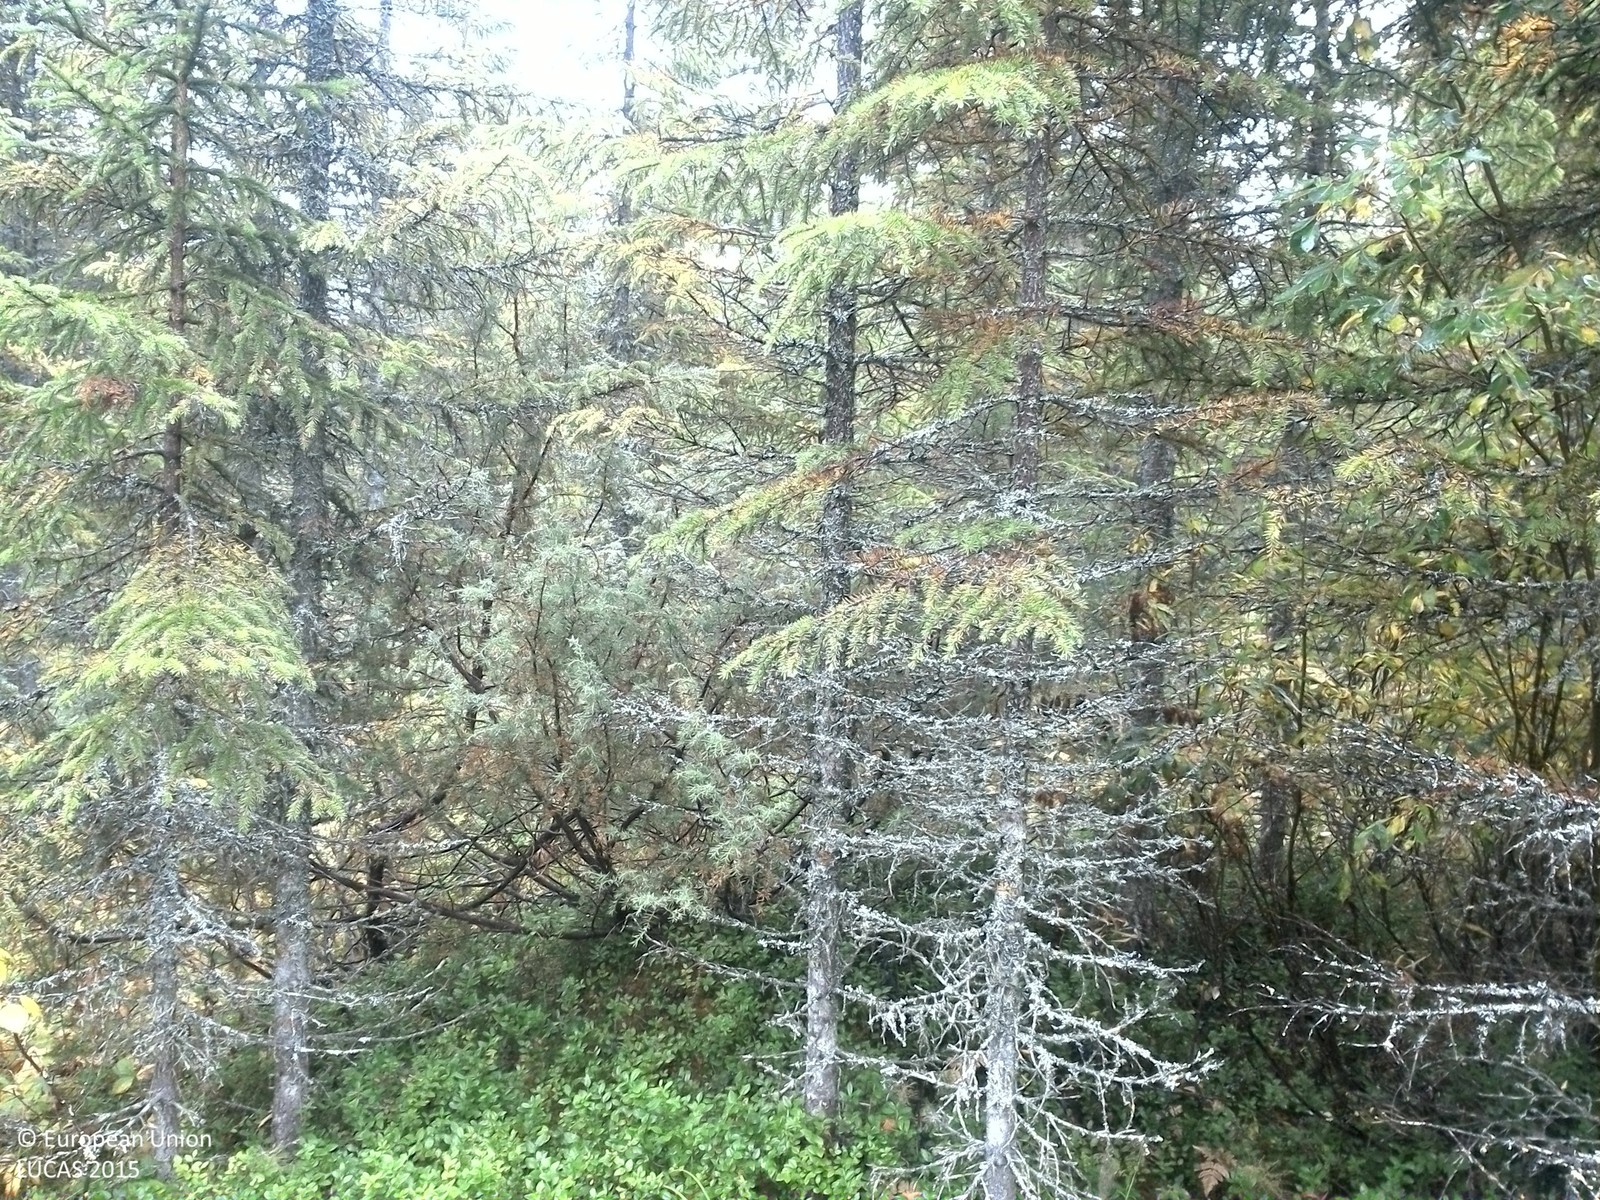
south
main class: Woodland
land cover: Spruce dominated coniferous woodland
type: boreal forest
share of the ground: 50 - 75 %
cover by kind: coniferous forest trees 60 %, shrubs 20 %, lichens and mosses 10 %, broadleaved forest trees 5 %, herbaceous plants 5 %
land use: Forestry
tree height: > 5 m
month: September
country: SE
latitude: 63.6206
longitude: 15.8442
